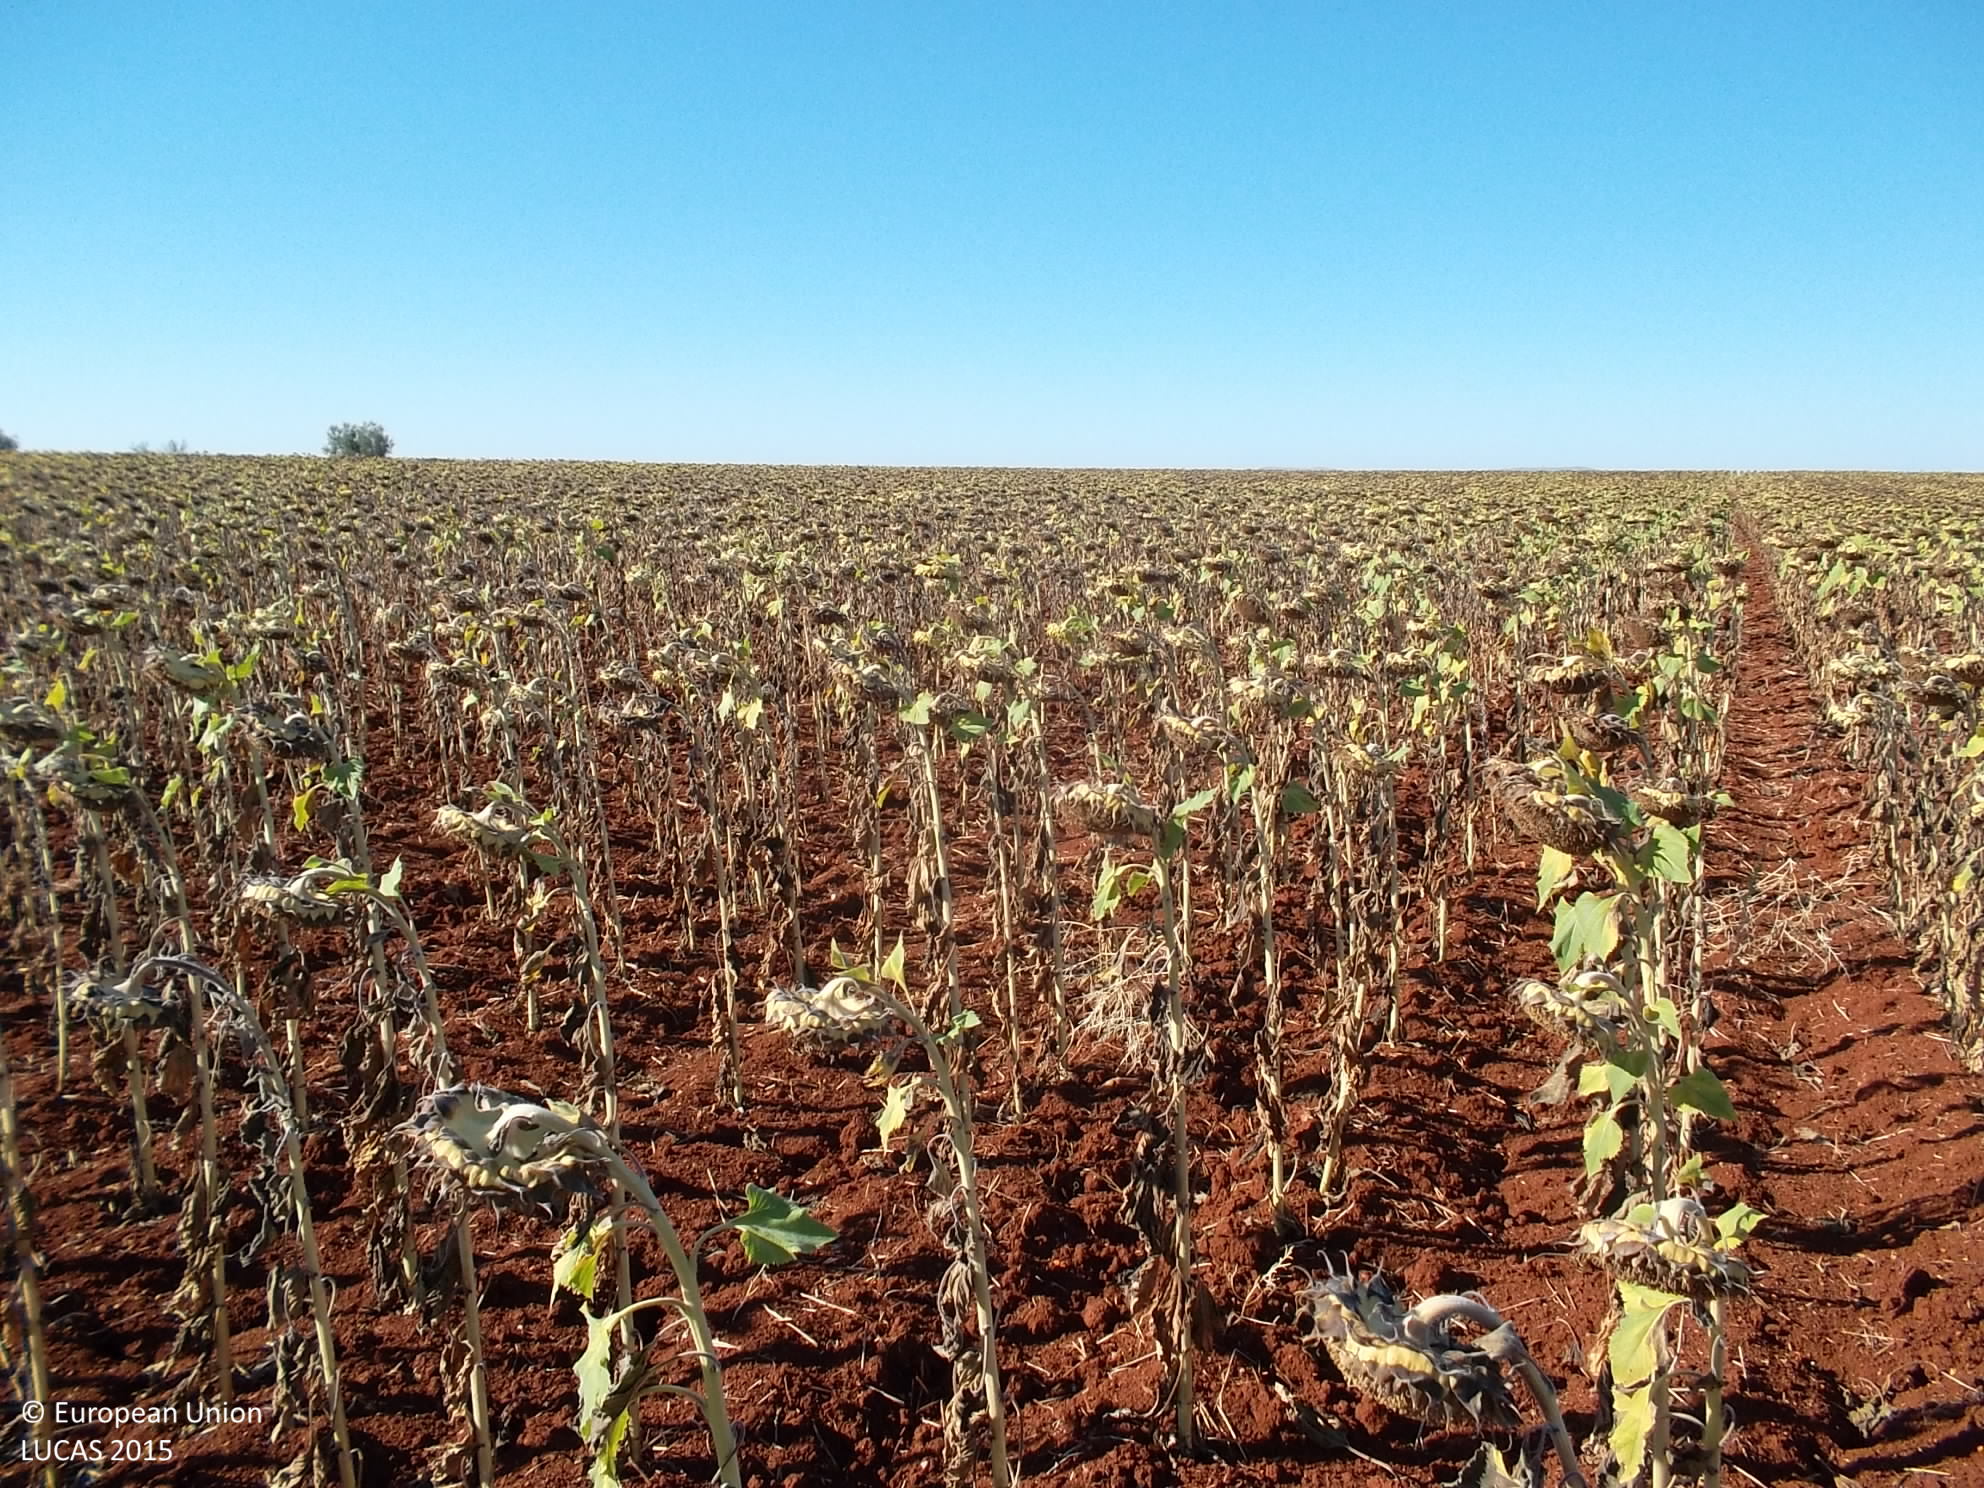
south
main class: Cropland
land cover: Sunflower
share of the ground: > 75 %
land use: Agriculture (excluding fallow land and kitchen gardens)
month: July
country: ES
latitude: 38.3744
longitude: -5.7769
